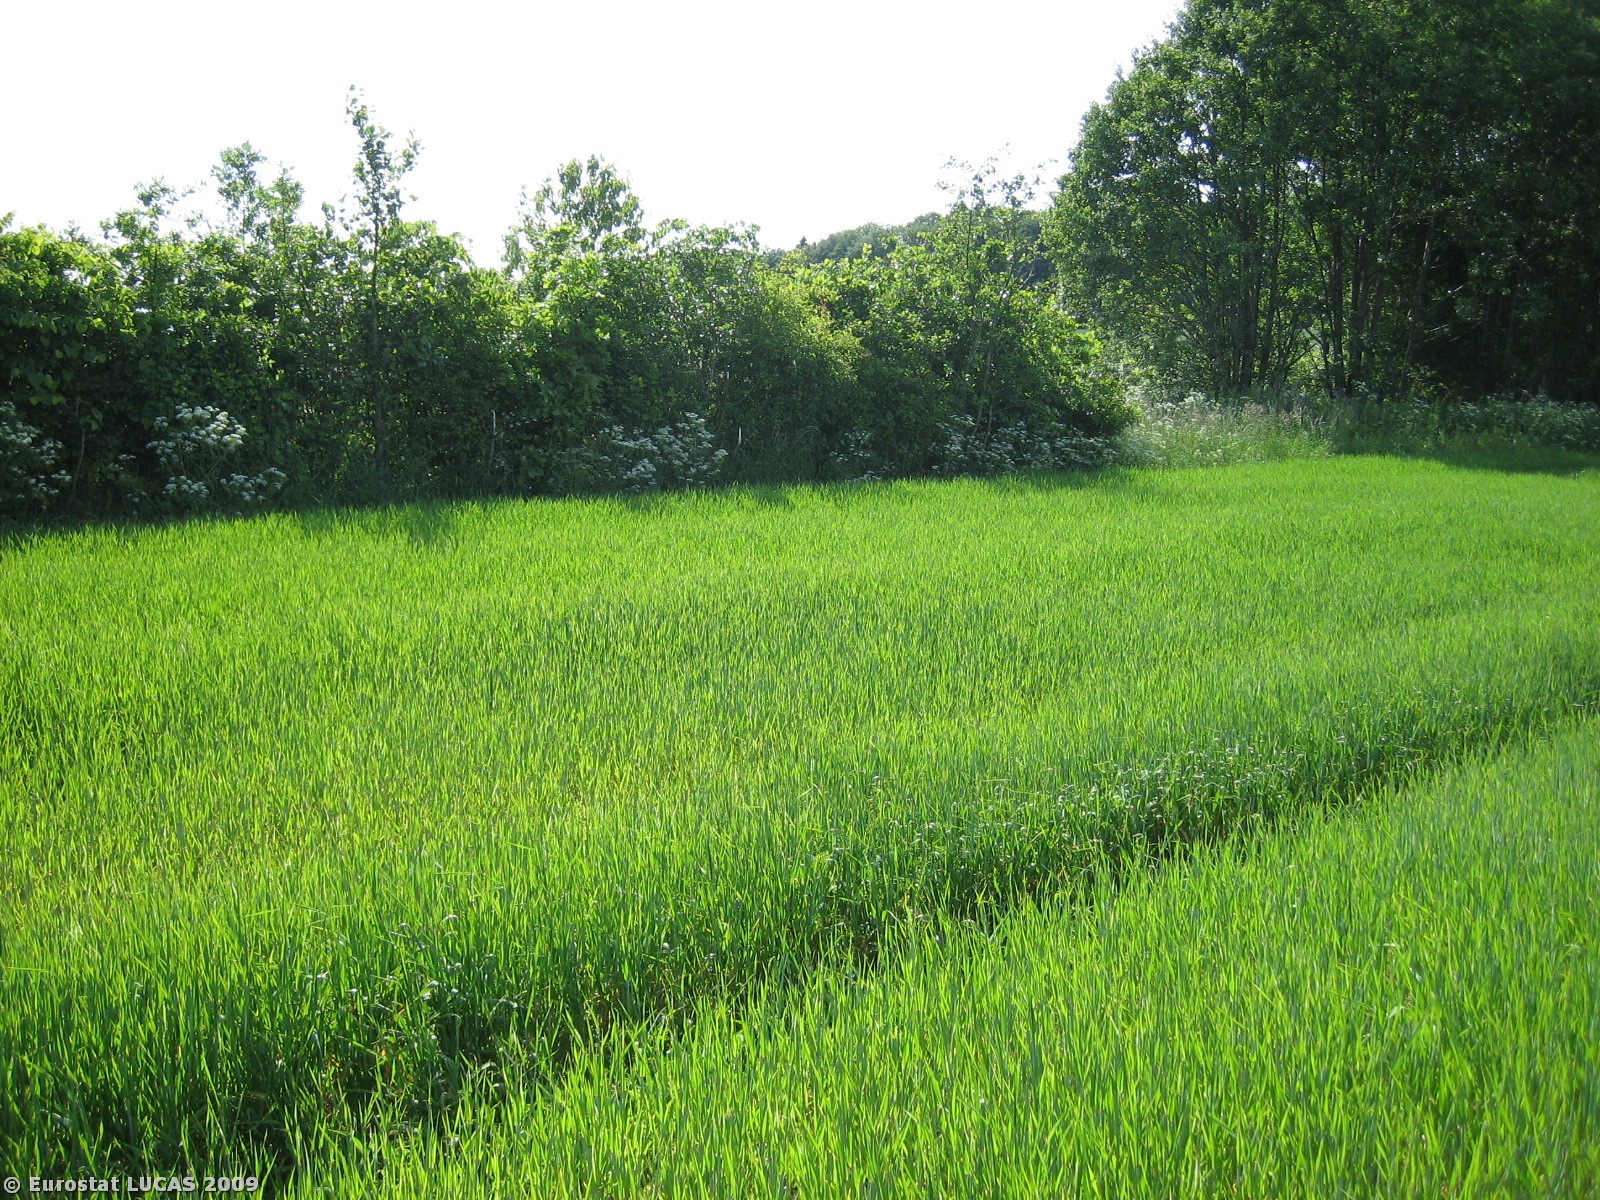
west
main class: Cropland
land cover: Barley
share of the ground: > 75 %
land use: Agriculture (excluding fallow land and kitchen gardens)
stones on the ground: < 10 %
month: June
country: DK
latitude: 56.1877
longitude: 9.8873
